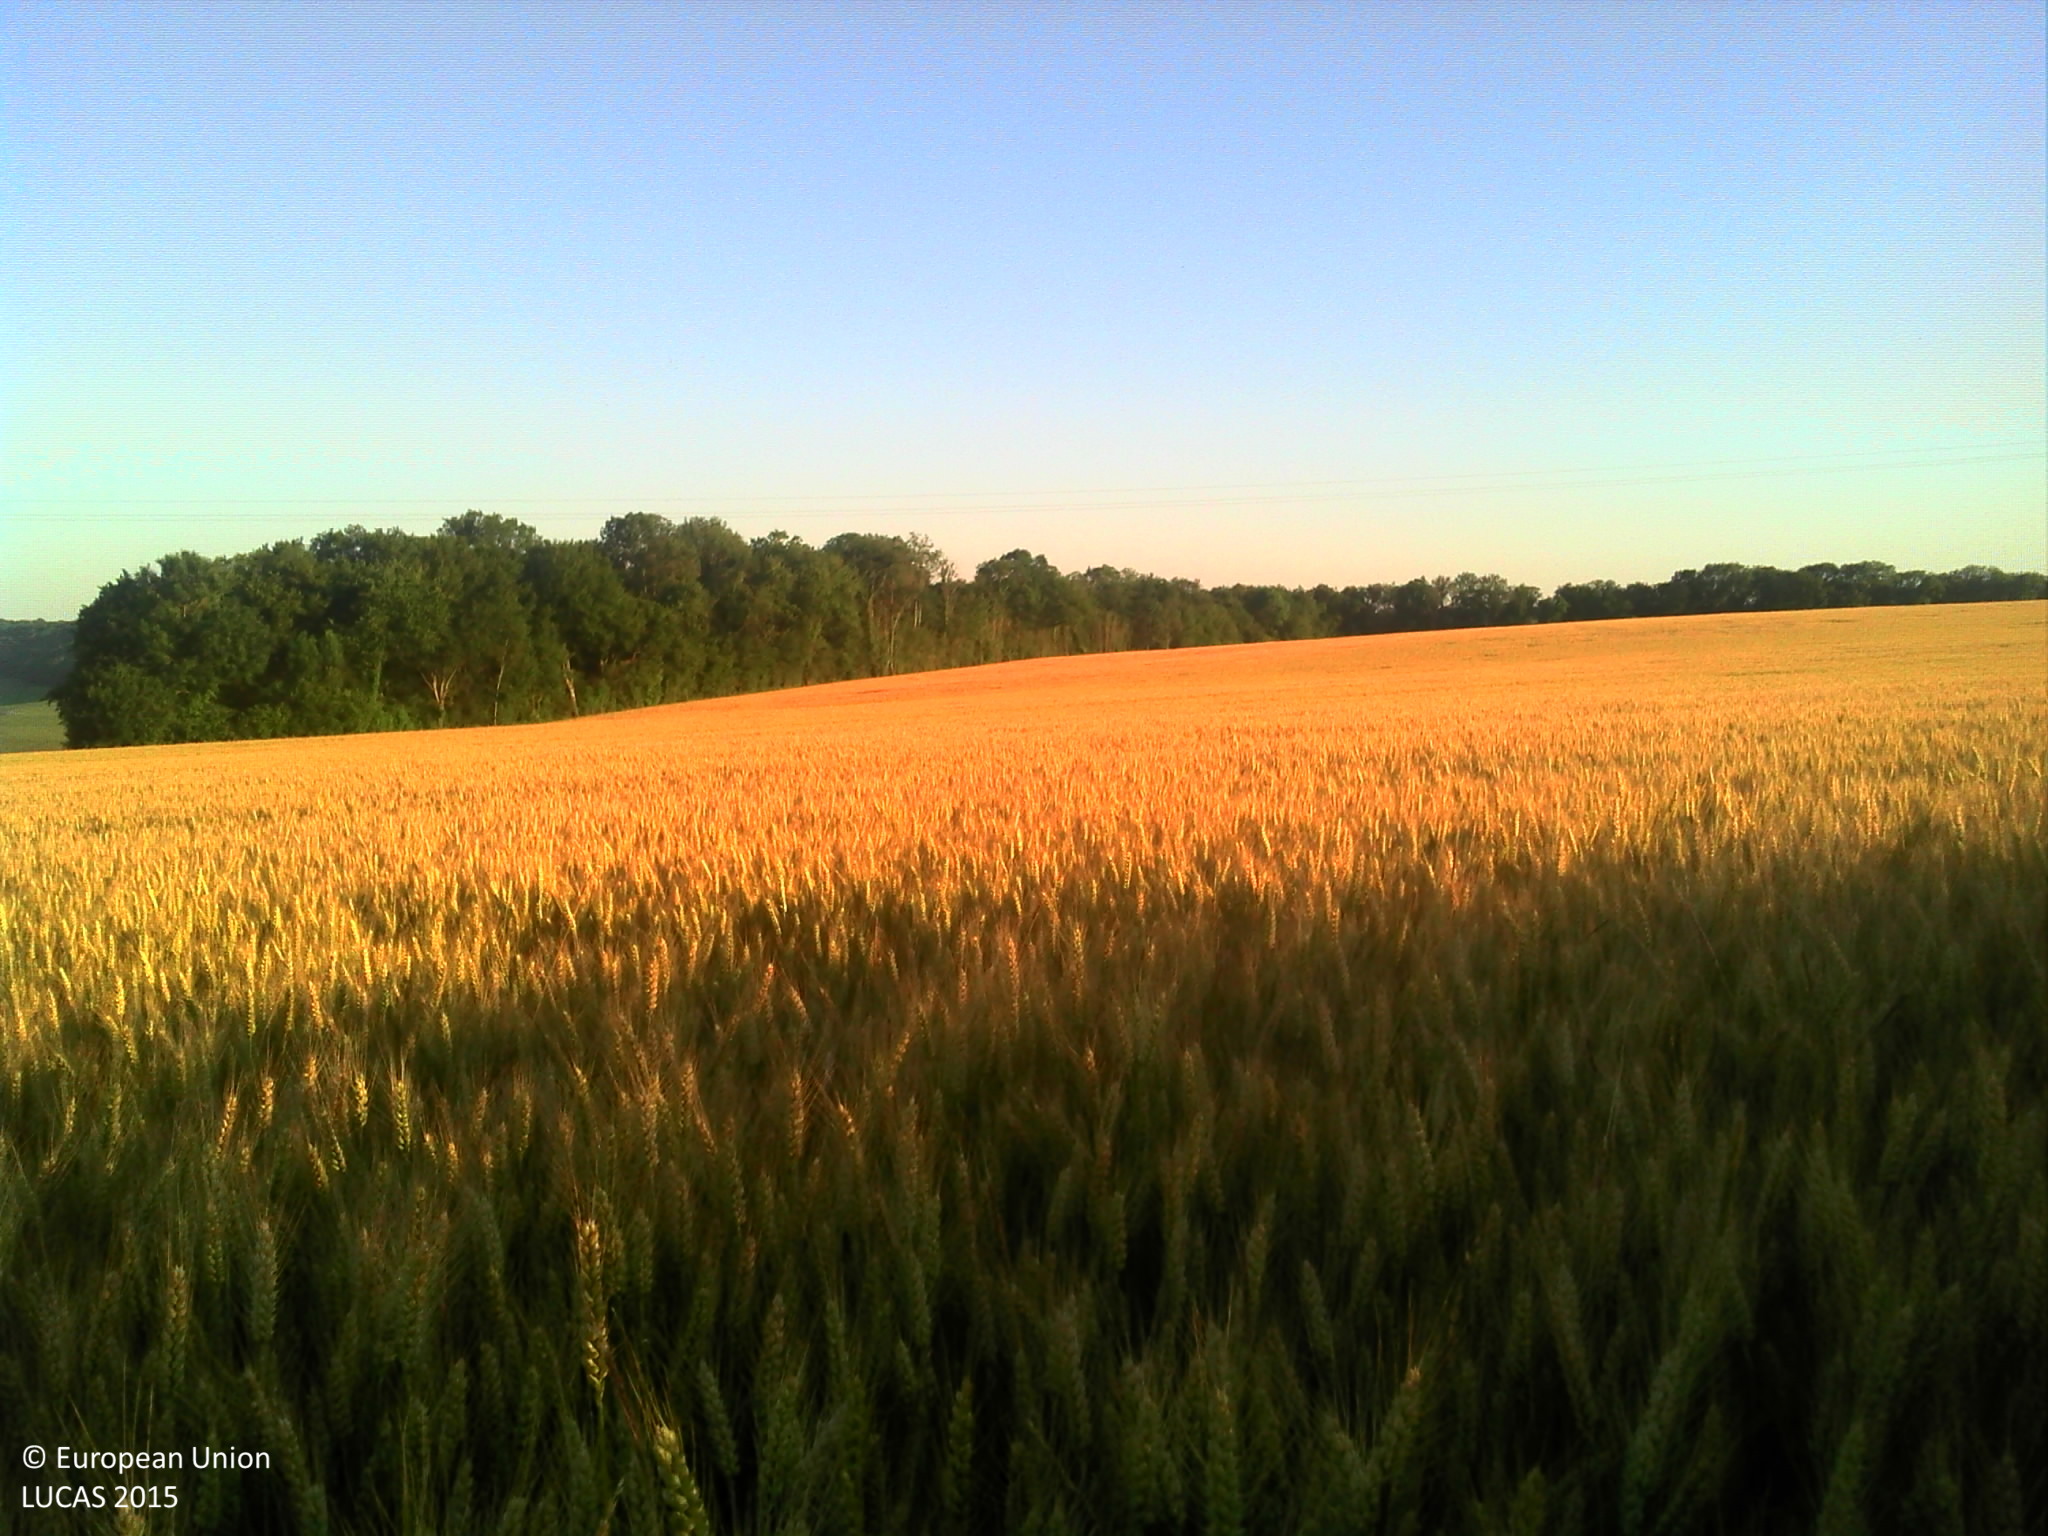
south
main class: Cropland
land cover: Rape and turnip rape
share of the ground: > 75 %
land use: Agriculture (excluding fallow land and kitchen gardens)
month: June
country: FR
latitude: 48.0363
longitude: 5.3726
